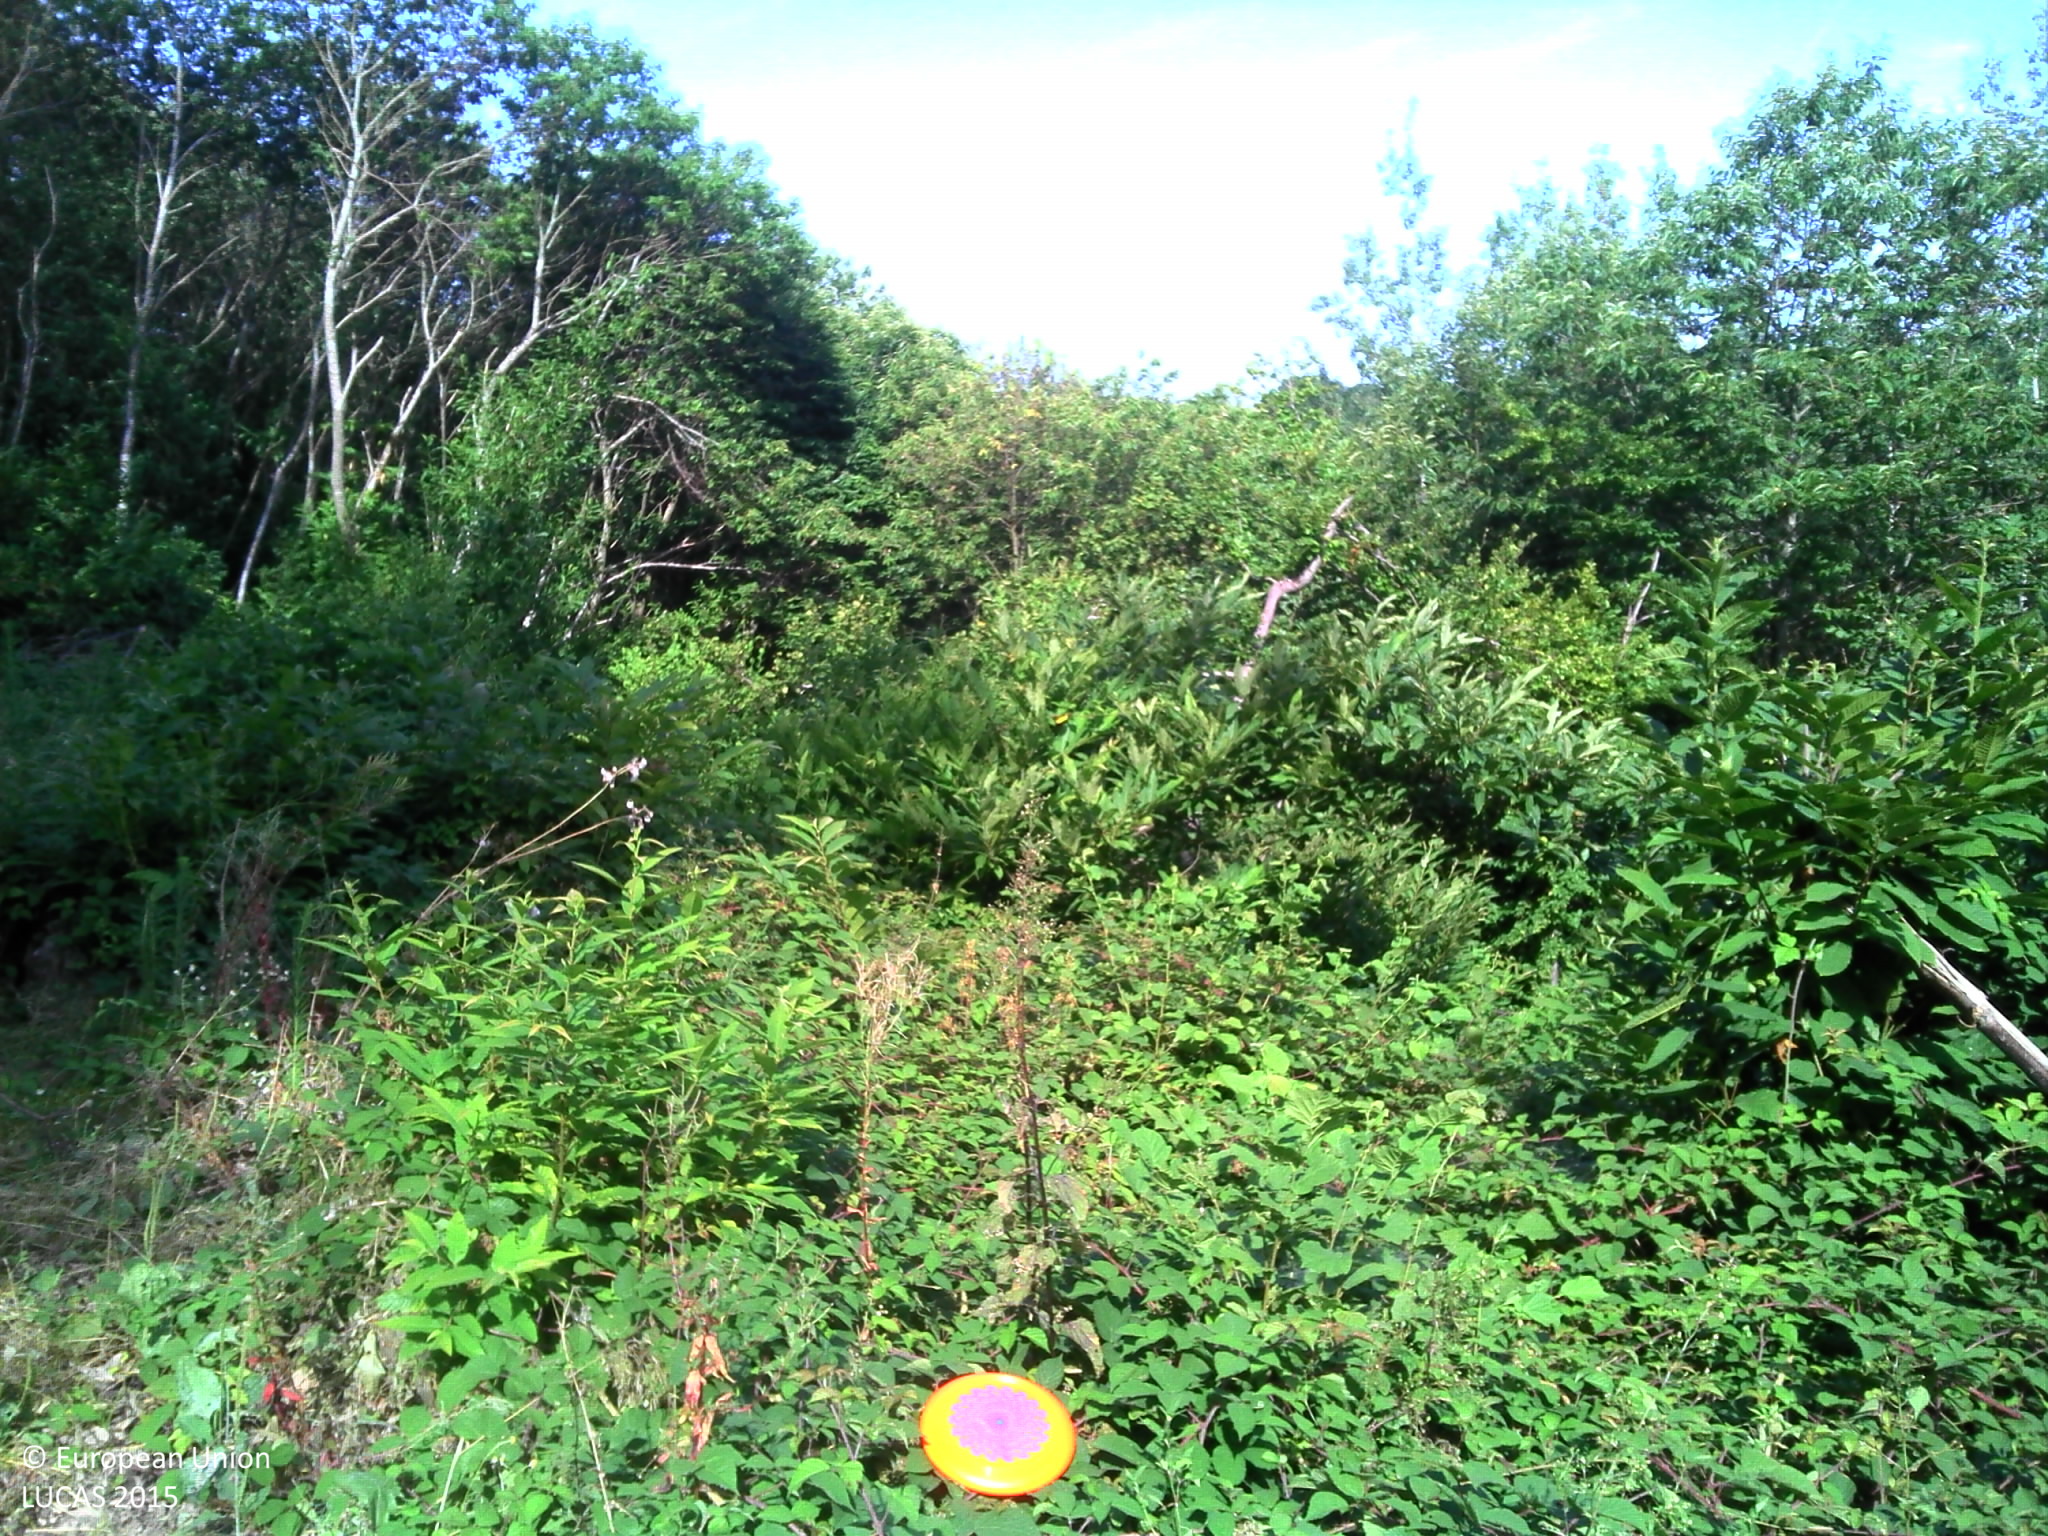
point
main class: Woodland
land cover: Broadleaved woodland
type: floodplain forest
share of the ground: > 75 %
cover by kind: broadleaved forest trees 50 %, herbaceous plants 50 %
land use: Forestry
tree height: > 5 m
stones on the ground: 10 - 25 %
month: July
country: FR
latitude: 45.4960
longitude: 5.4362
